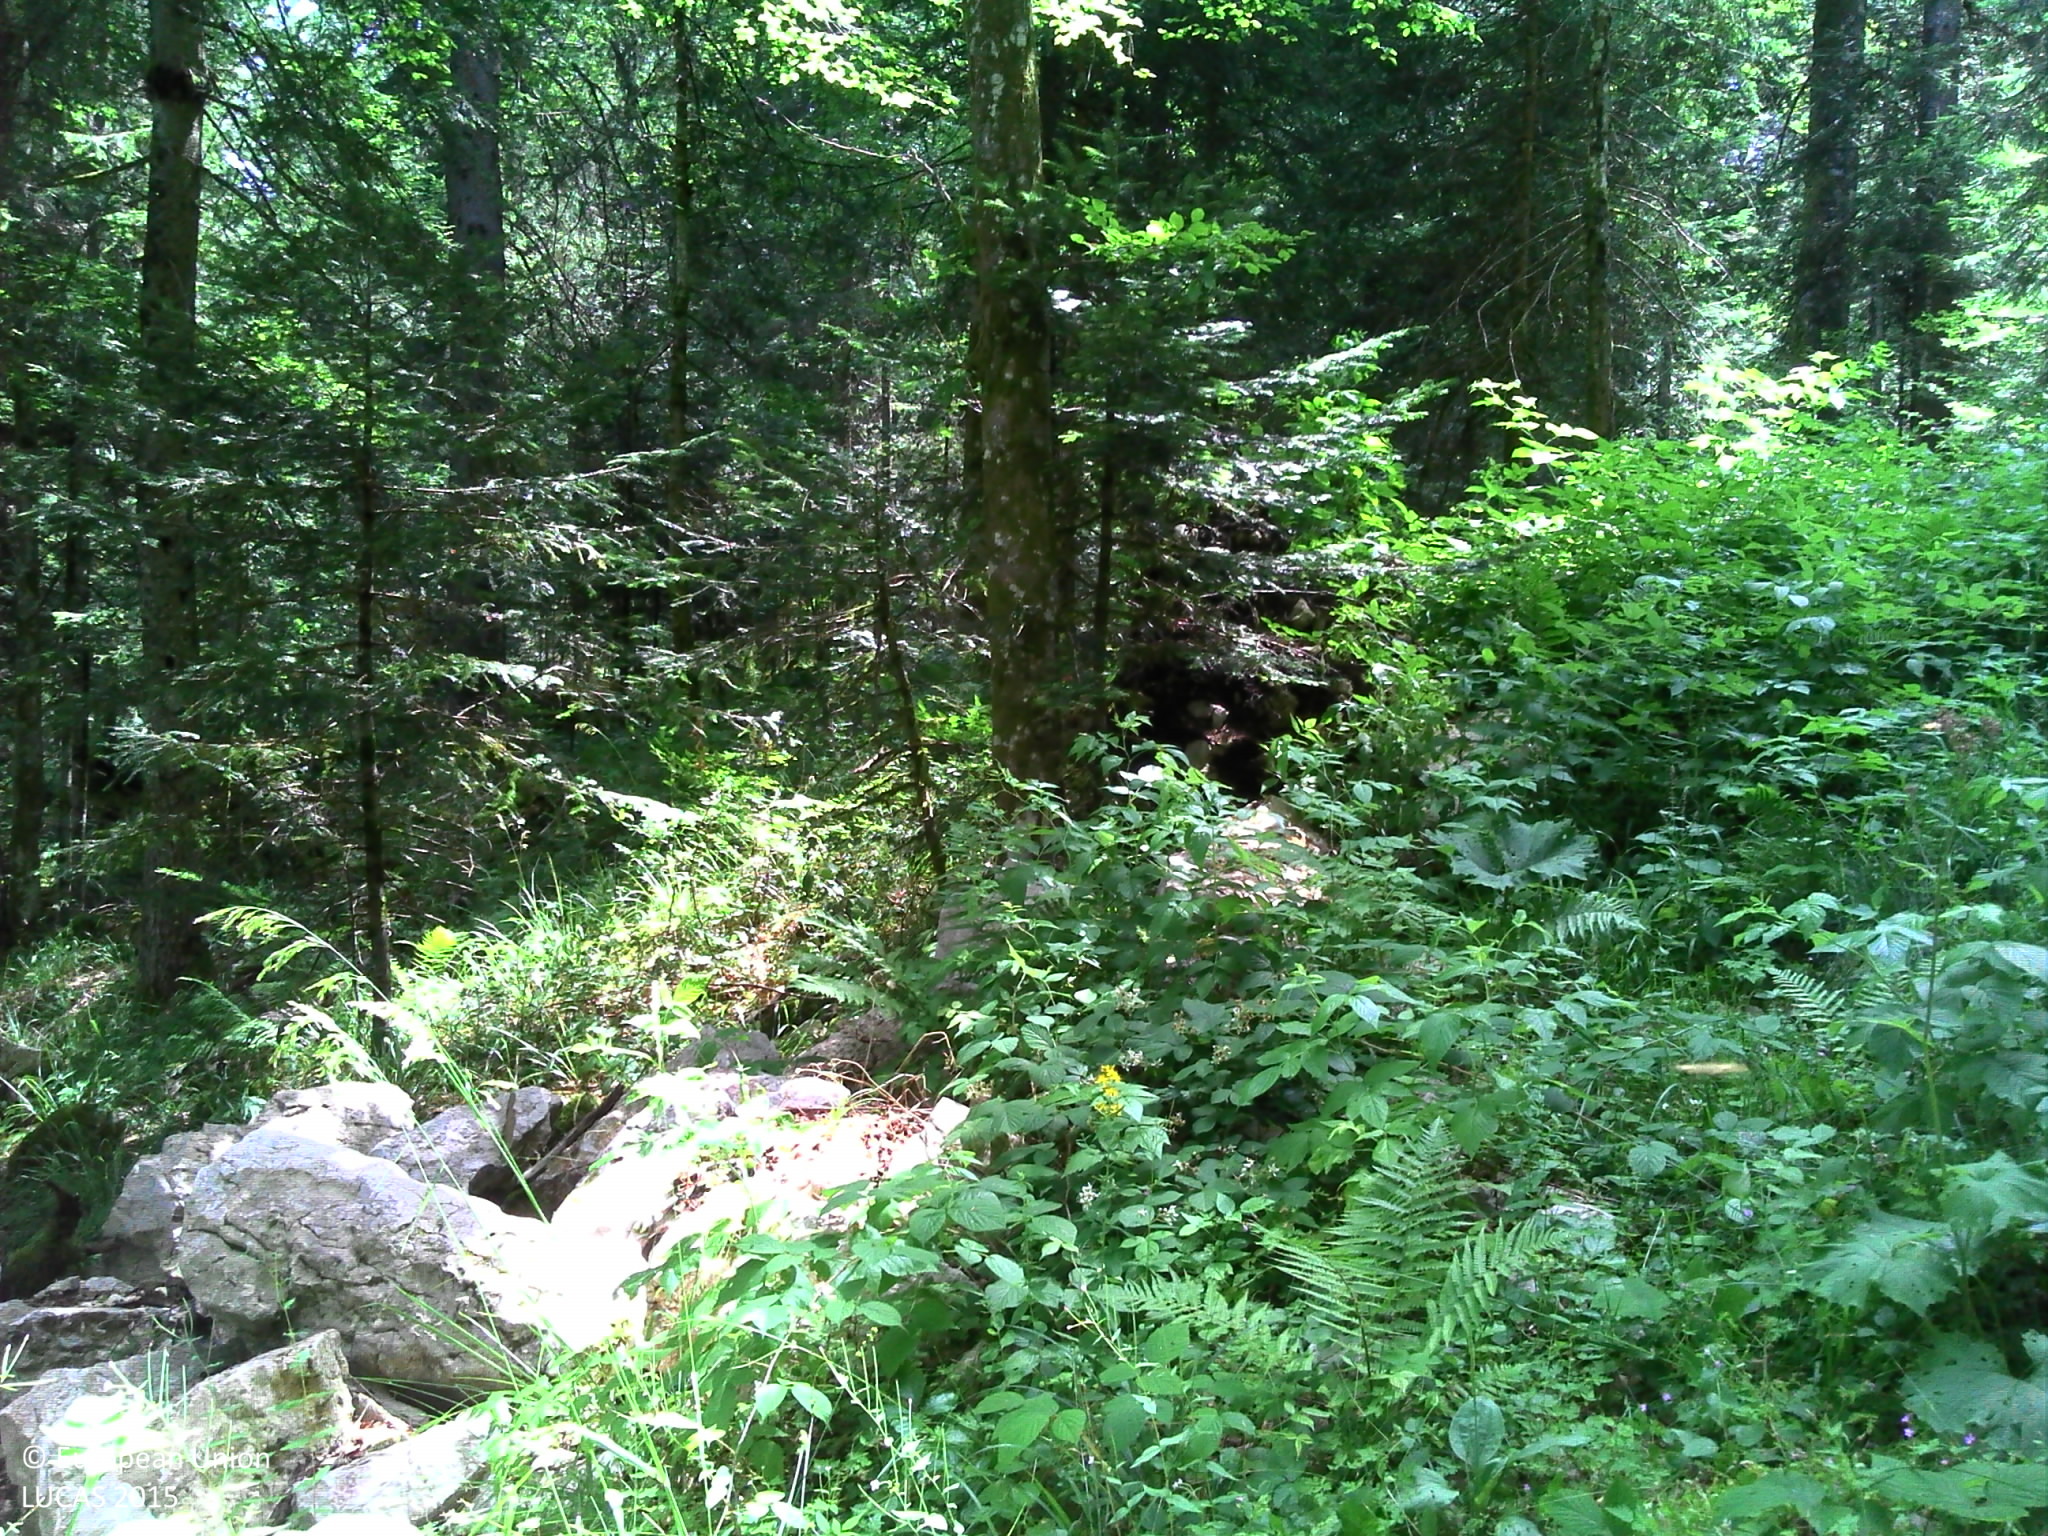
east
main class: Woodland
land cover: Spruce dominated mixed woodland
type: mountainous beech forest
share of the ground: > 75 %
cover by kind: coniferous forest trees 30 %, broadleaved forest trees 30 %, shrubs 10 %, herbaceous plants 10 %, lichens and mosses 10 %, consolidated bare surface 10 %
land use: Forestry
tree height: > 5 m
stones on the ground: > 50 %
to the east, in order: Spruce dominated mixed woodland; Rock outcrops; Tracks; Spruce dominated mixed woodland
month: July
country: FR
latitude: 46.7324
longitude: 6.1422
